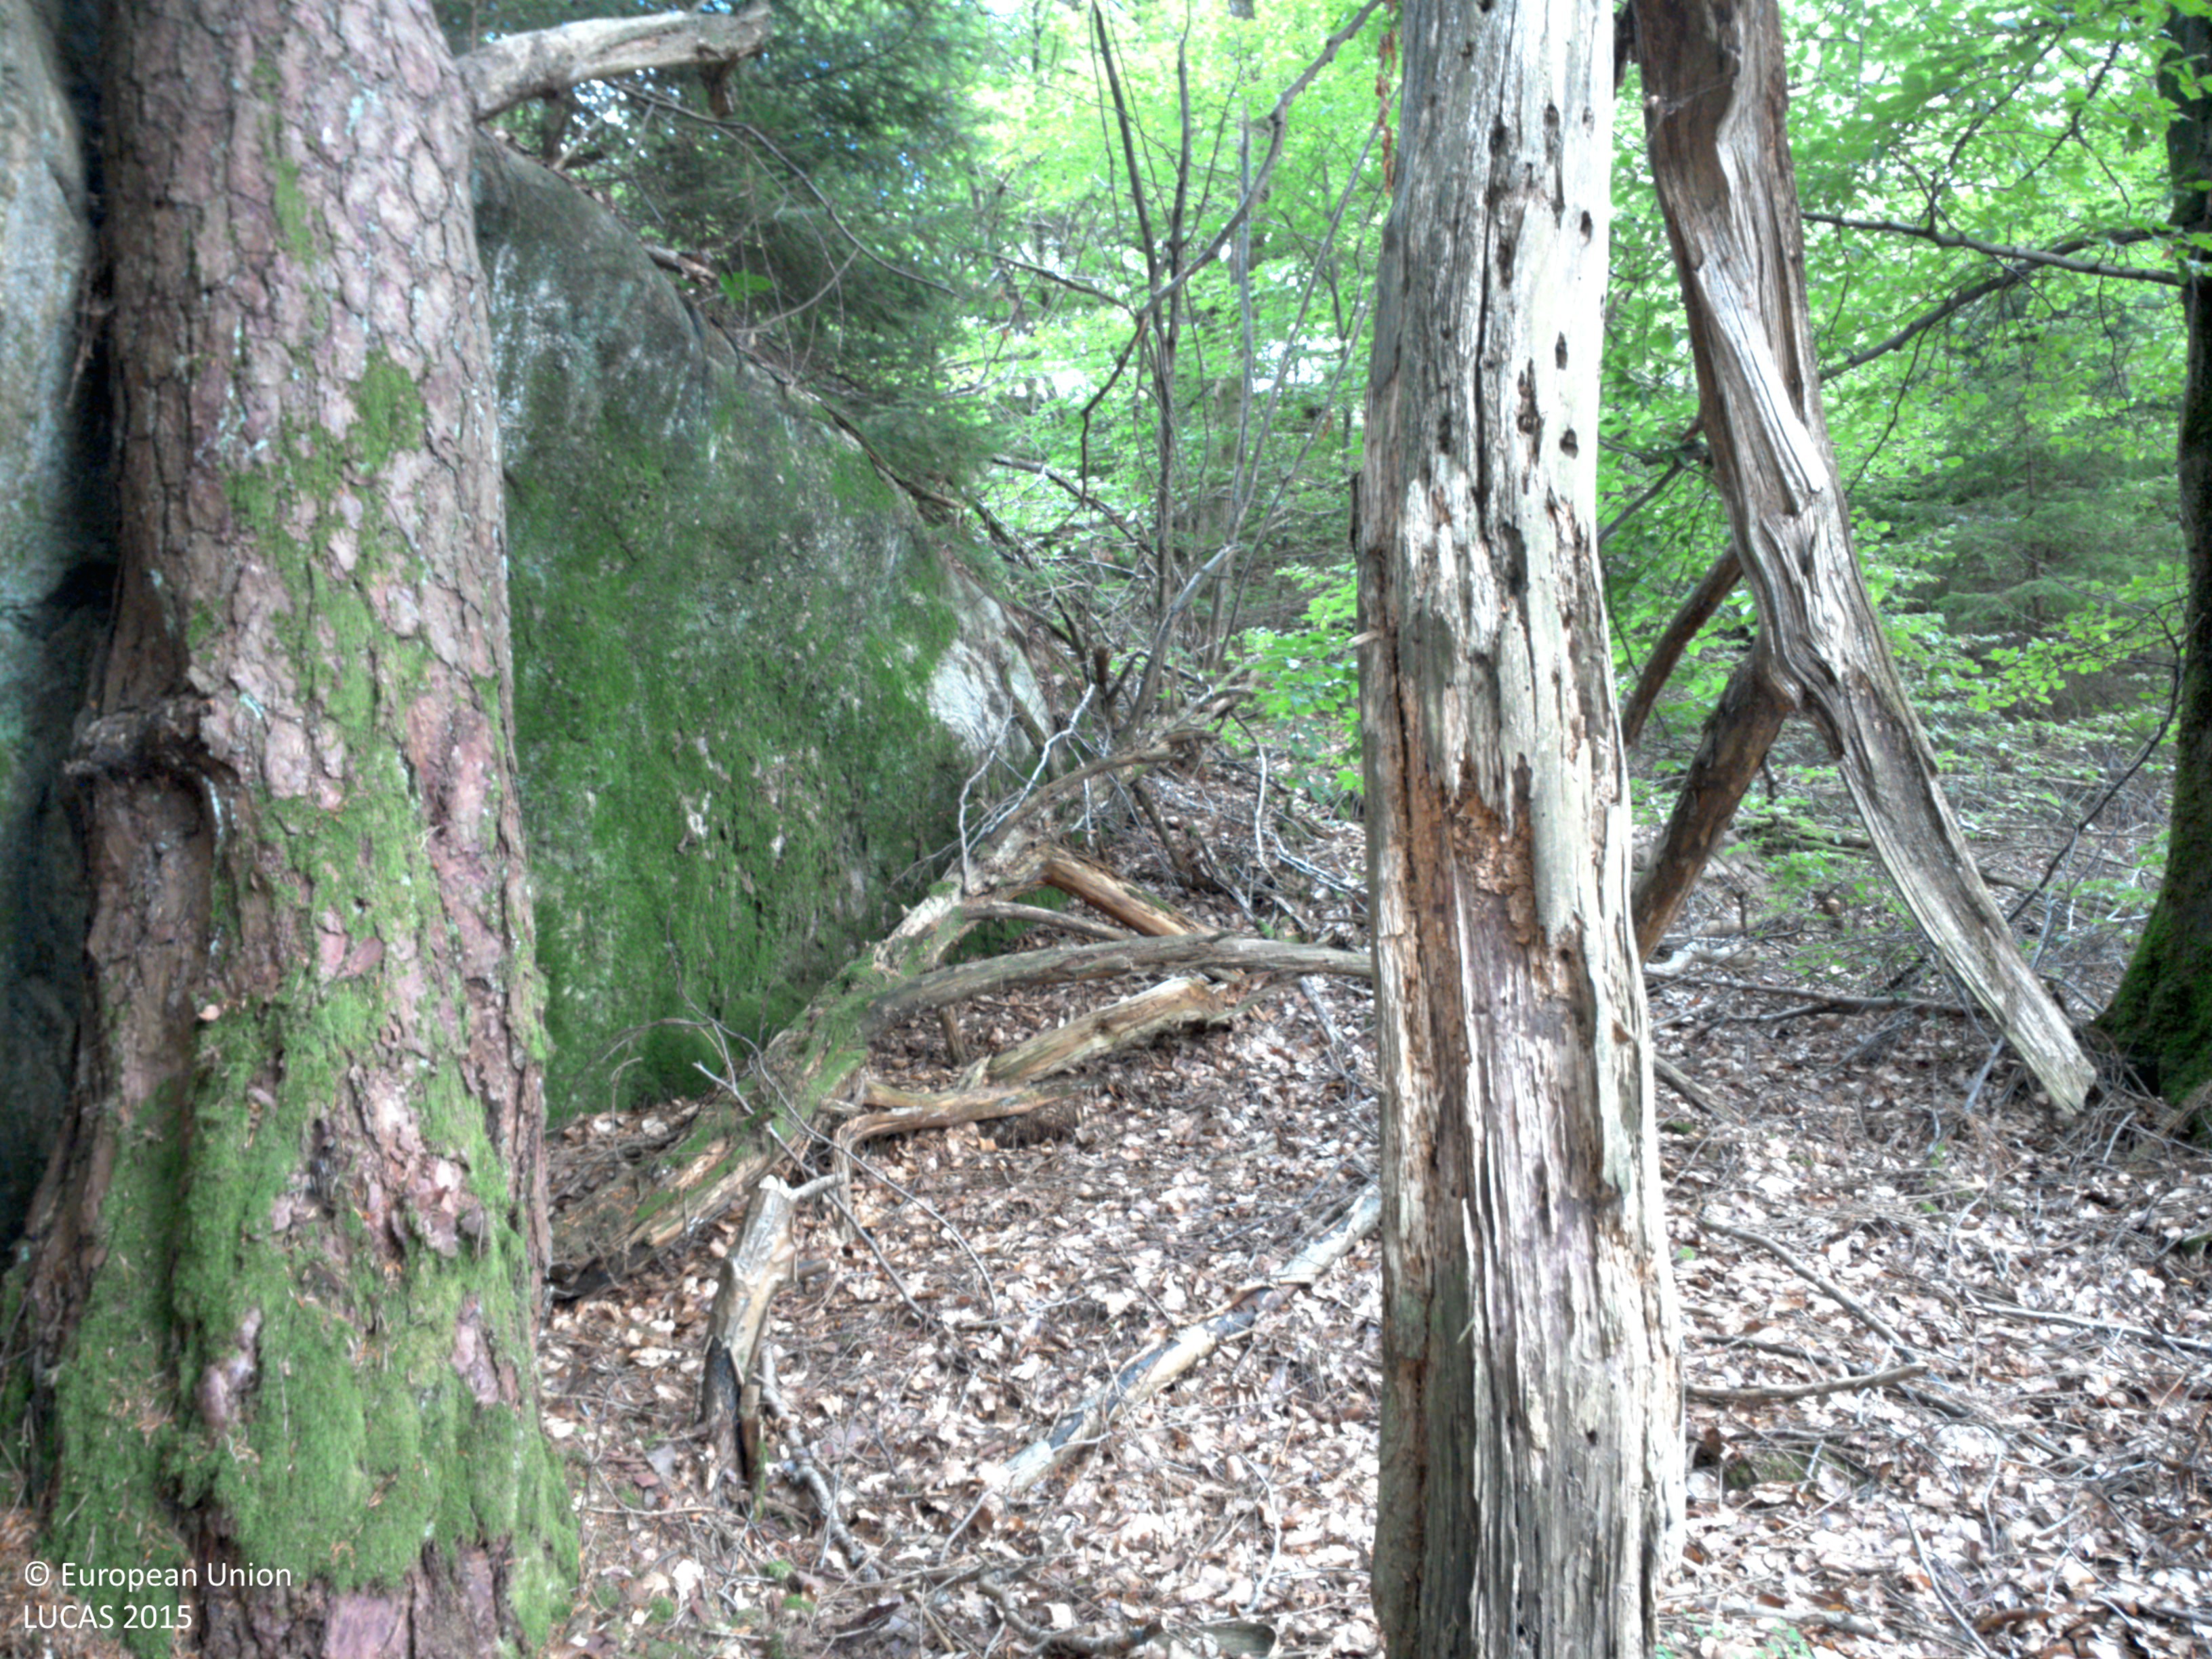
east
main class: Woodland
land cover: Spruce dominated mixed woodland
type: boreal forest
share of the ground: 50 - 75 %
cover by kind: unconsolidated bare surface 40 %, broadleaved forest trees 35 %, coniferous forest trees 20 %, shrubs 5 %
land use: Forestry
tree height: > 5 m
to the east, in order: Spruce dominated mixed woodland; Other mixed woodland; Broadleaved woodland; Pine dominated mixed woodland; Broadleaved woodland; Pine dominated mixed woodland; Shrubland with sparse tree cover; Rocks and stones; Shrubland with sparse tree cover; Other mixed woodland; Broadleaved woodland; Inland marshes; Broadleaved woodland
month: August
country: SE
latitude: 57.8652
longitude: 11.8340
